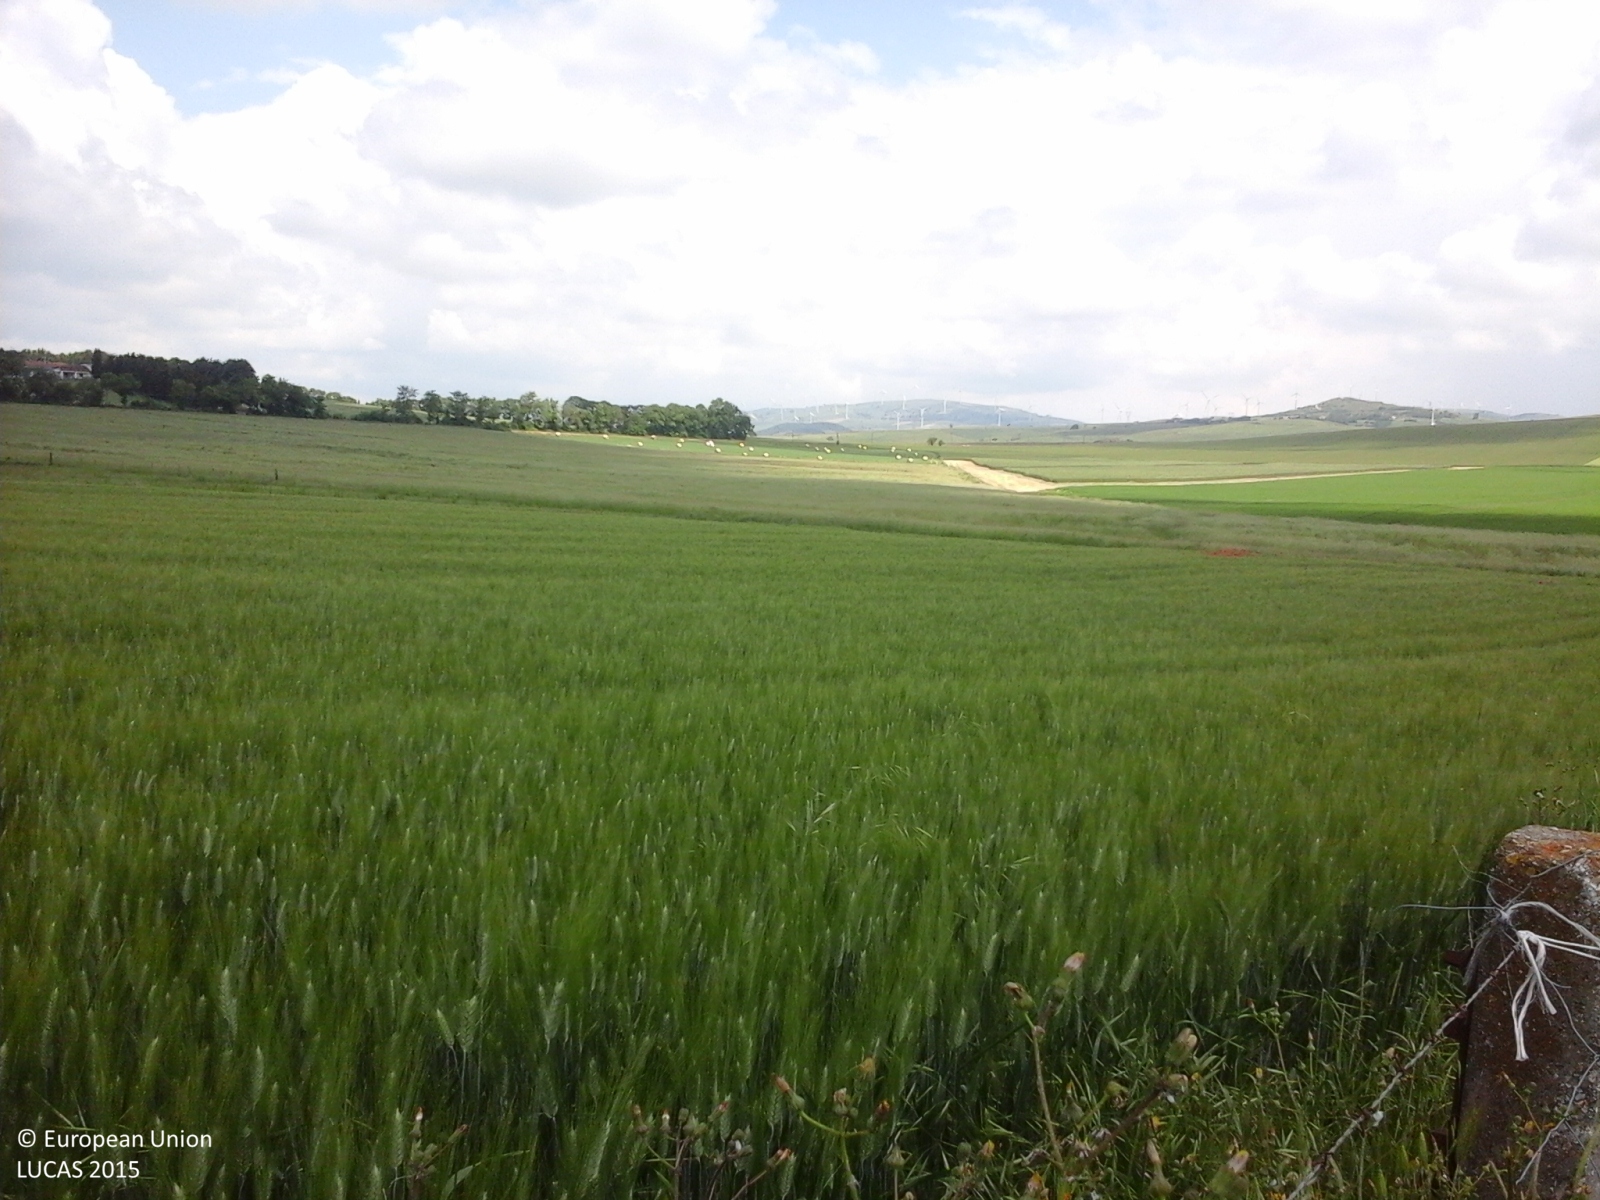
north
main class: Cropland
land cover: Durum wheat
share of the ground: > 75 %
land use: Agriculture (excluding fallow land and kitchen gardens)
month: May
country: IT
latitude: 41.2390
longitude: 15.1242
